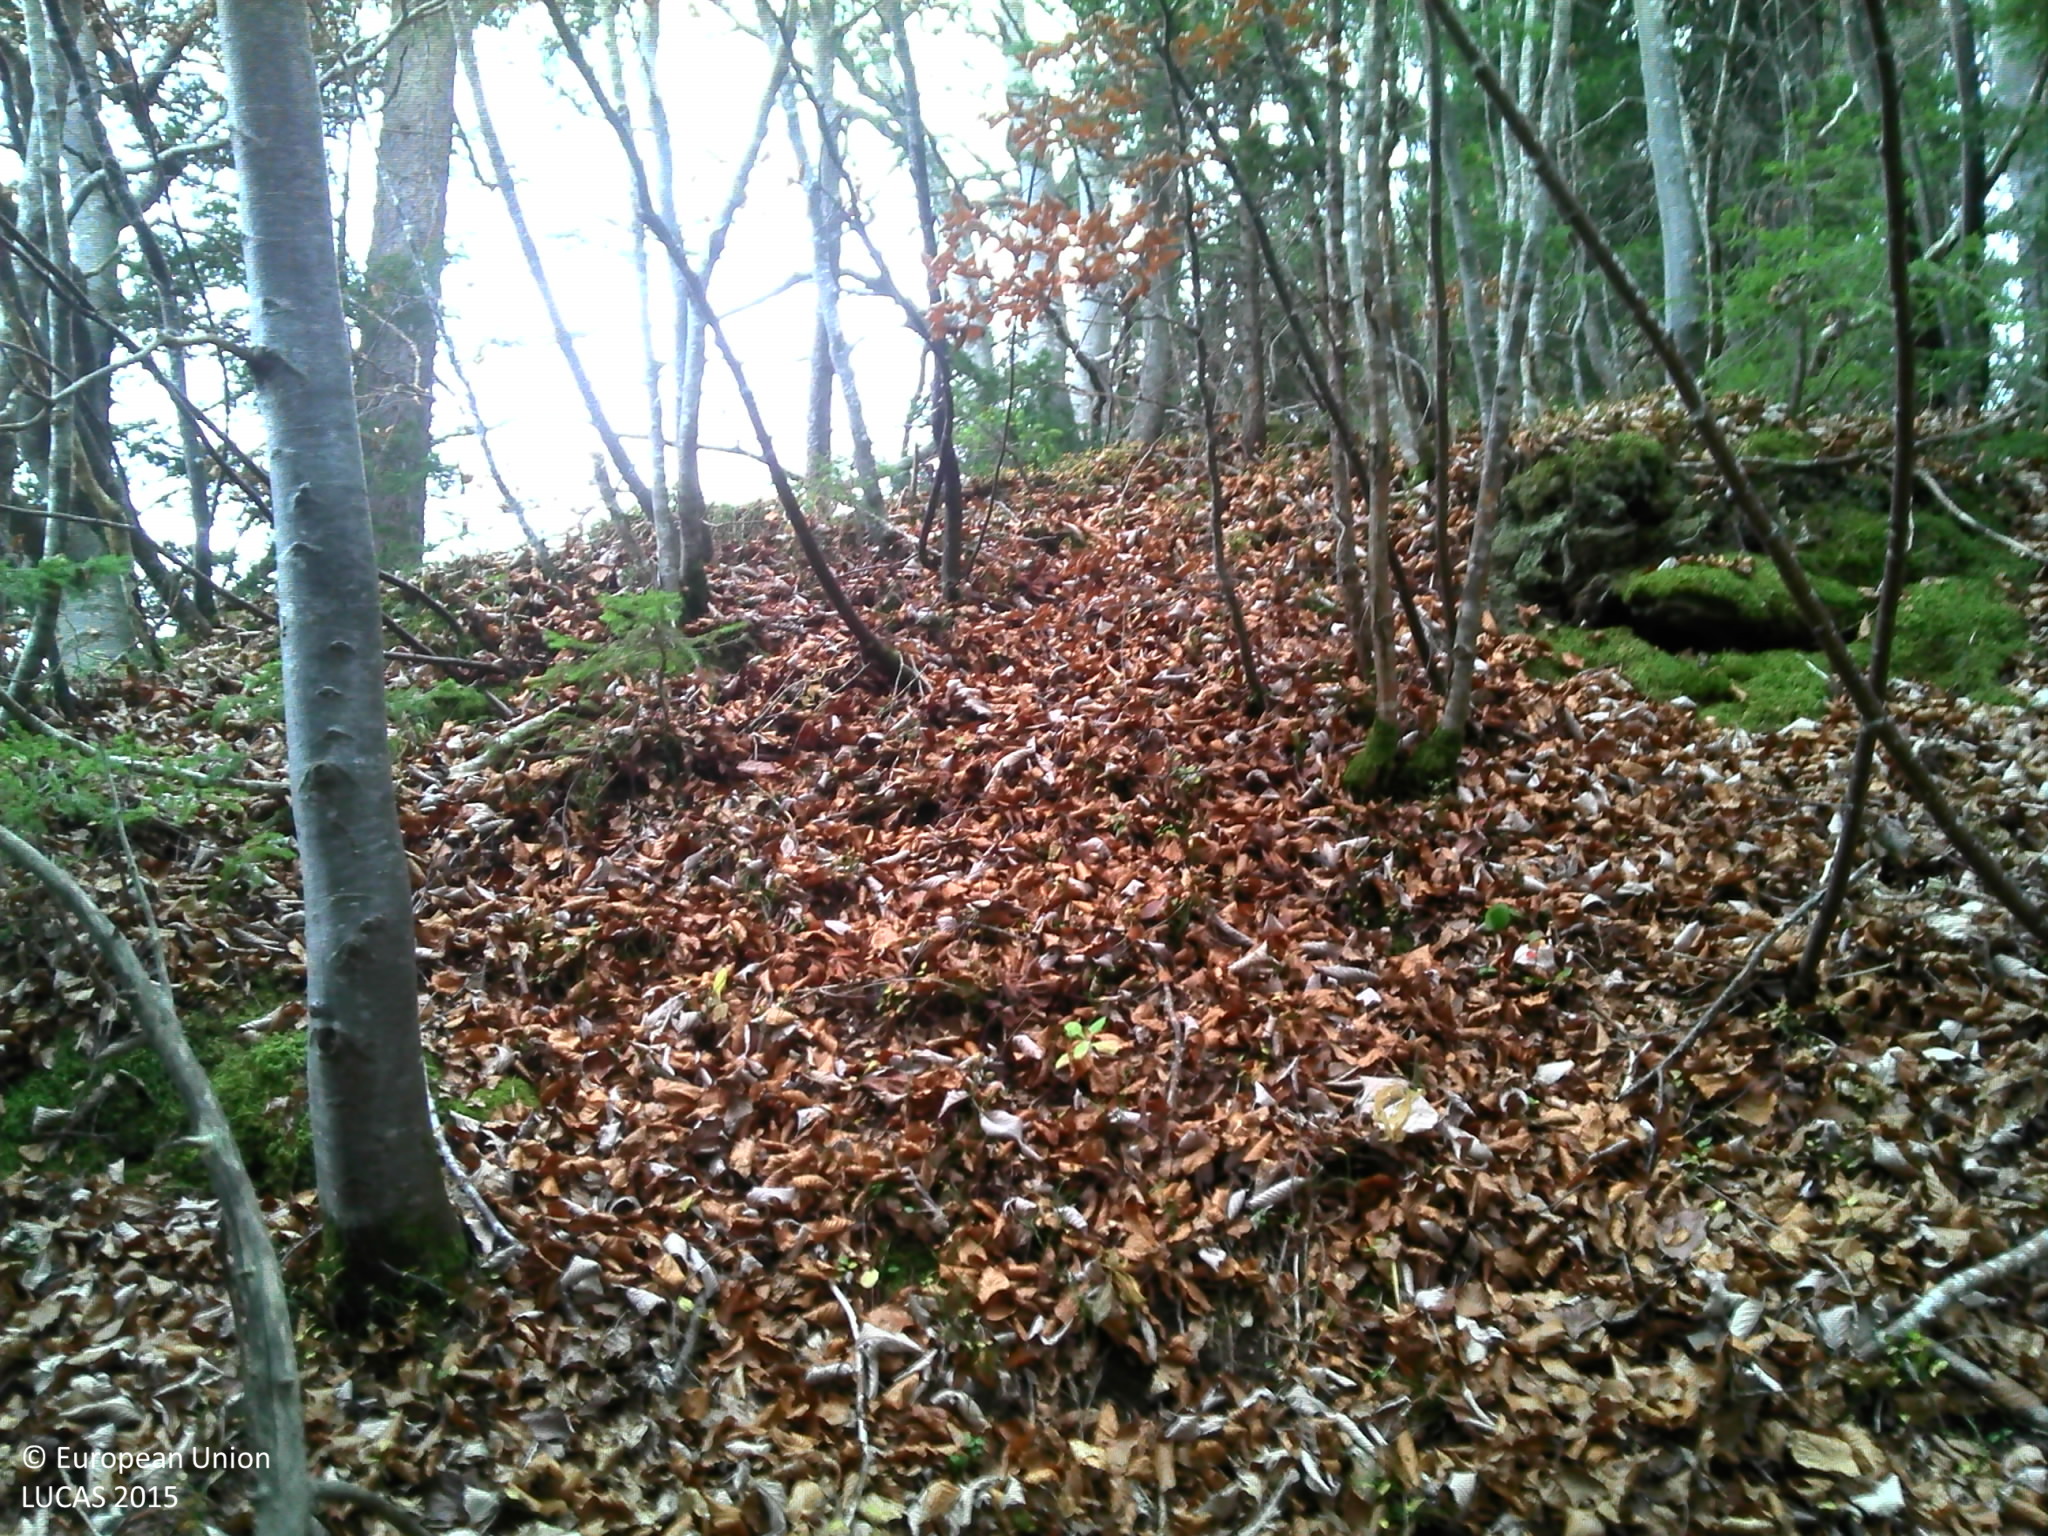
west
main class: Woodland
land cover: Spruce dominated mixed woodland
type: mountainous beech forest
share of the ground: > 75 %
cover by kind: coniferous forest trees 50 %, broadleaved forest trees 30 %, herbaceous plants 10 %, consolidated bare surface 10 %
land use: Forestry
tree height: > 5 m
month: November
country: FR
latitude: 45.8068
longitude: 6.4912
